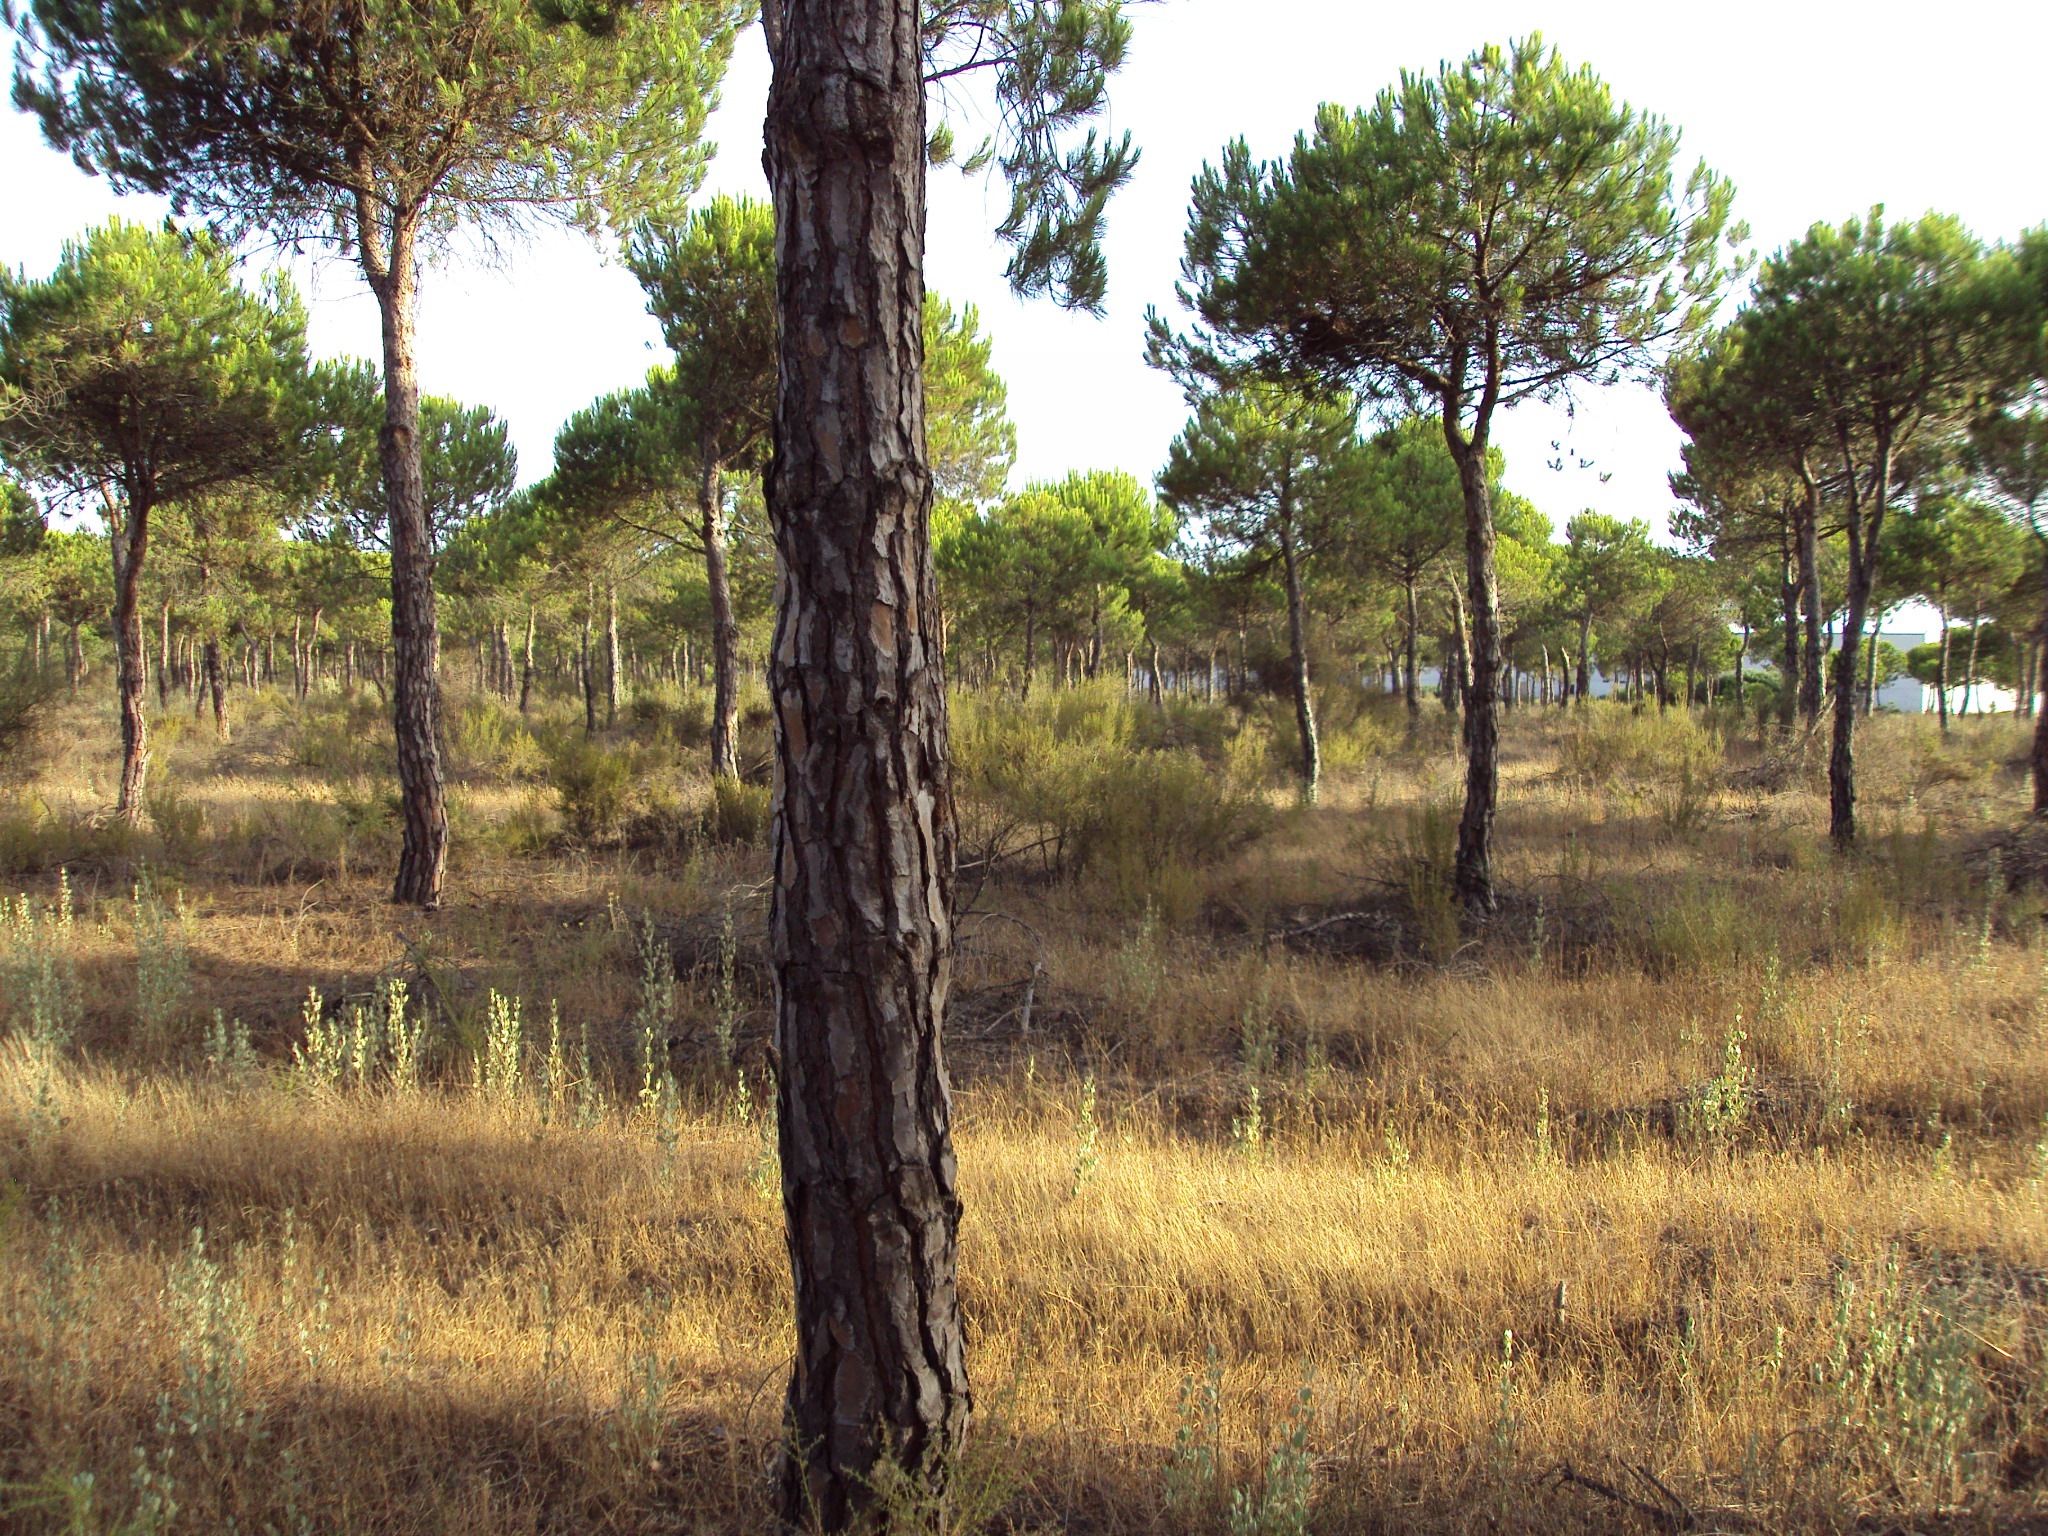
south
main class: Woodland
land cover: Pine dominated coniferous woodland
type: coniferous forest of the mediterranean region
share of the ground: 50 - 75 %
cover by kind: coniferous forest trees 60 %, shrubs 20 %, herbaceous plants 20 %
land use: Forestry
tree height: > 5 m
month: July
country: ES
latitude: 37.1429
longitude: -6.8193
